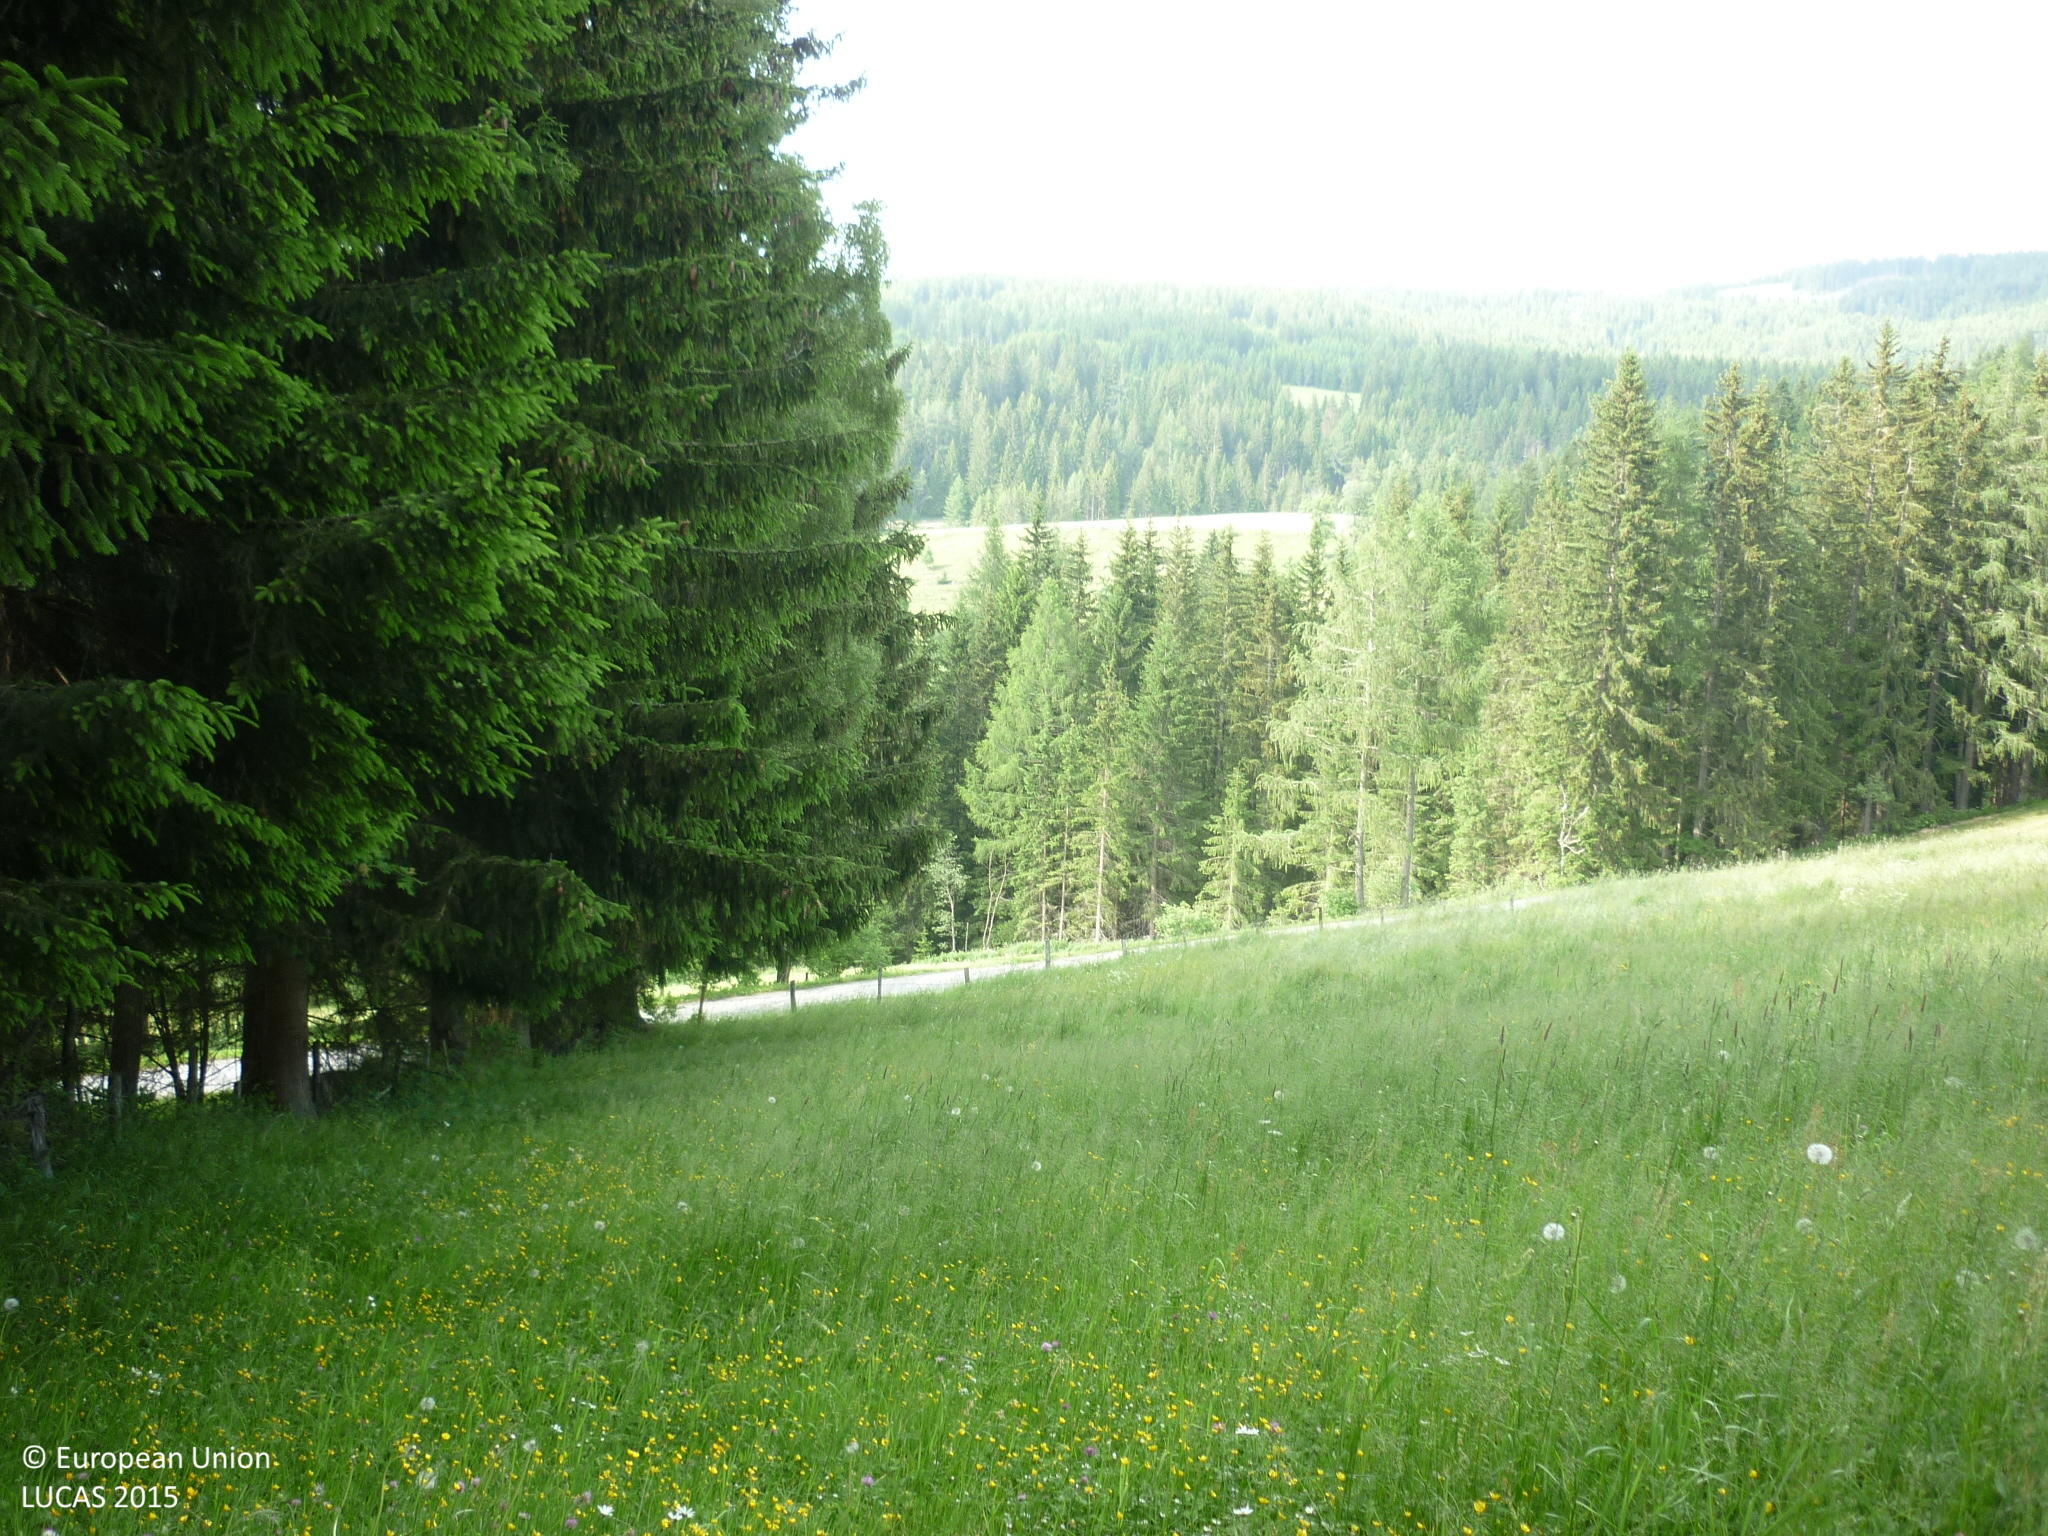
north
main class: Grassland
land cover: Grassland without tree/shrub cover
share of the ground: > 75 %
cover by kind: herbaceous plants 100 %
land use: Agriculture (excluding fallow land and kitchen gardens)
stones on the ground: < 10 %
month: June
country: AT
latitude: 47.2198
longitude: 14.3166
